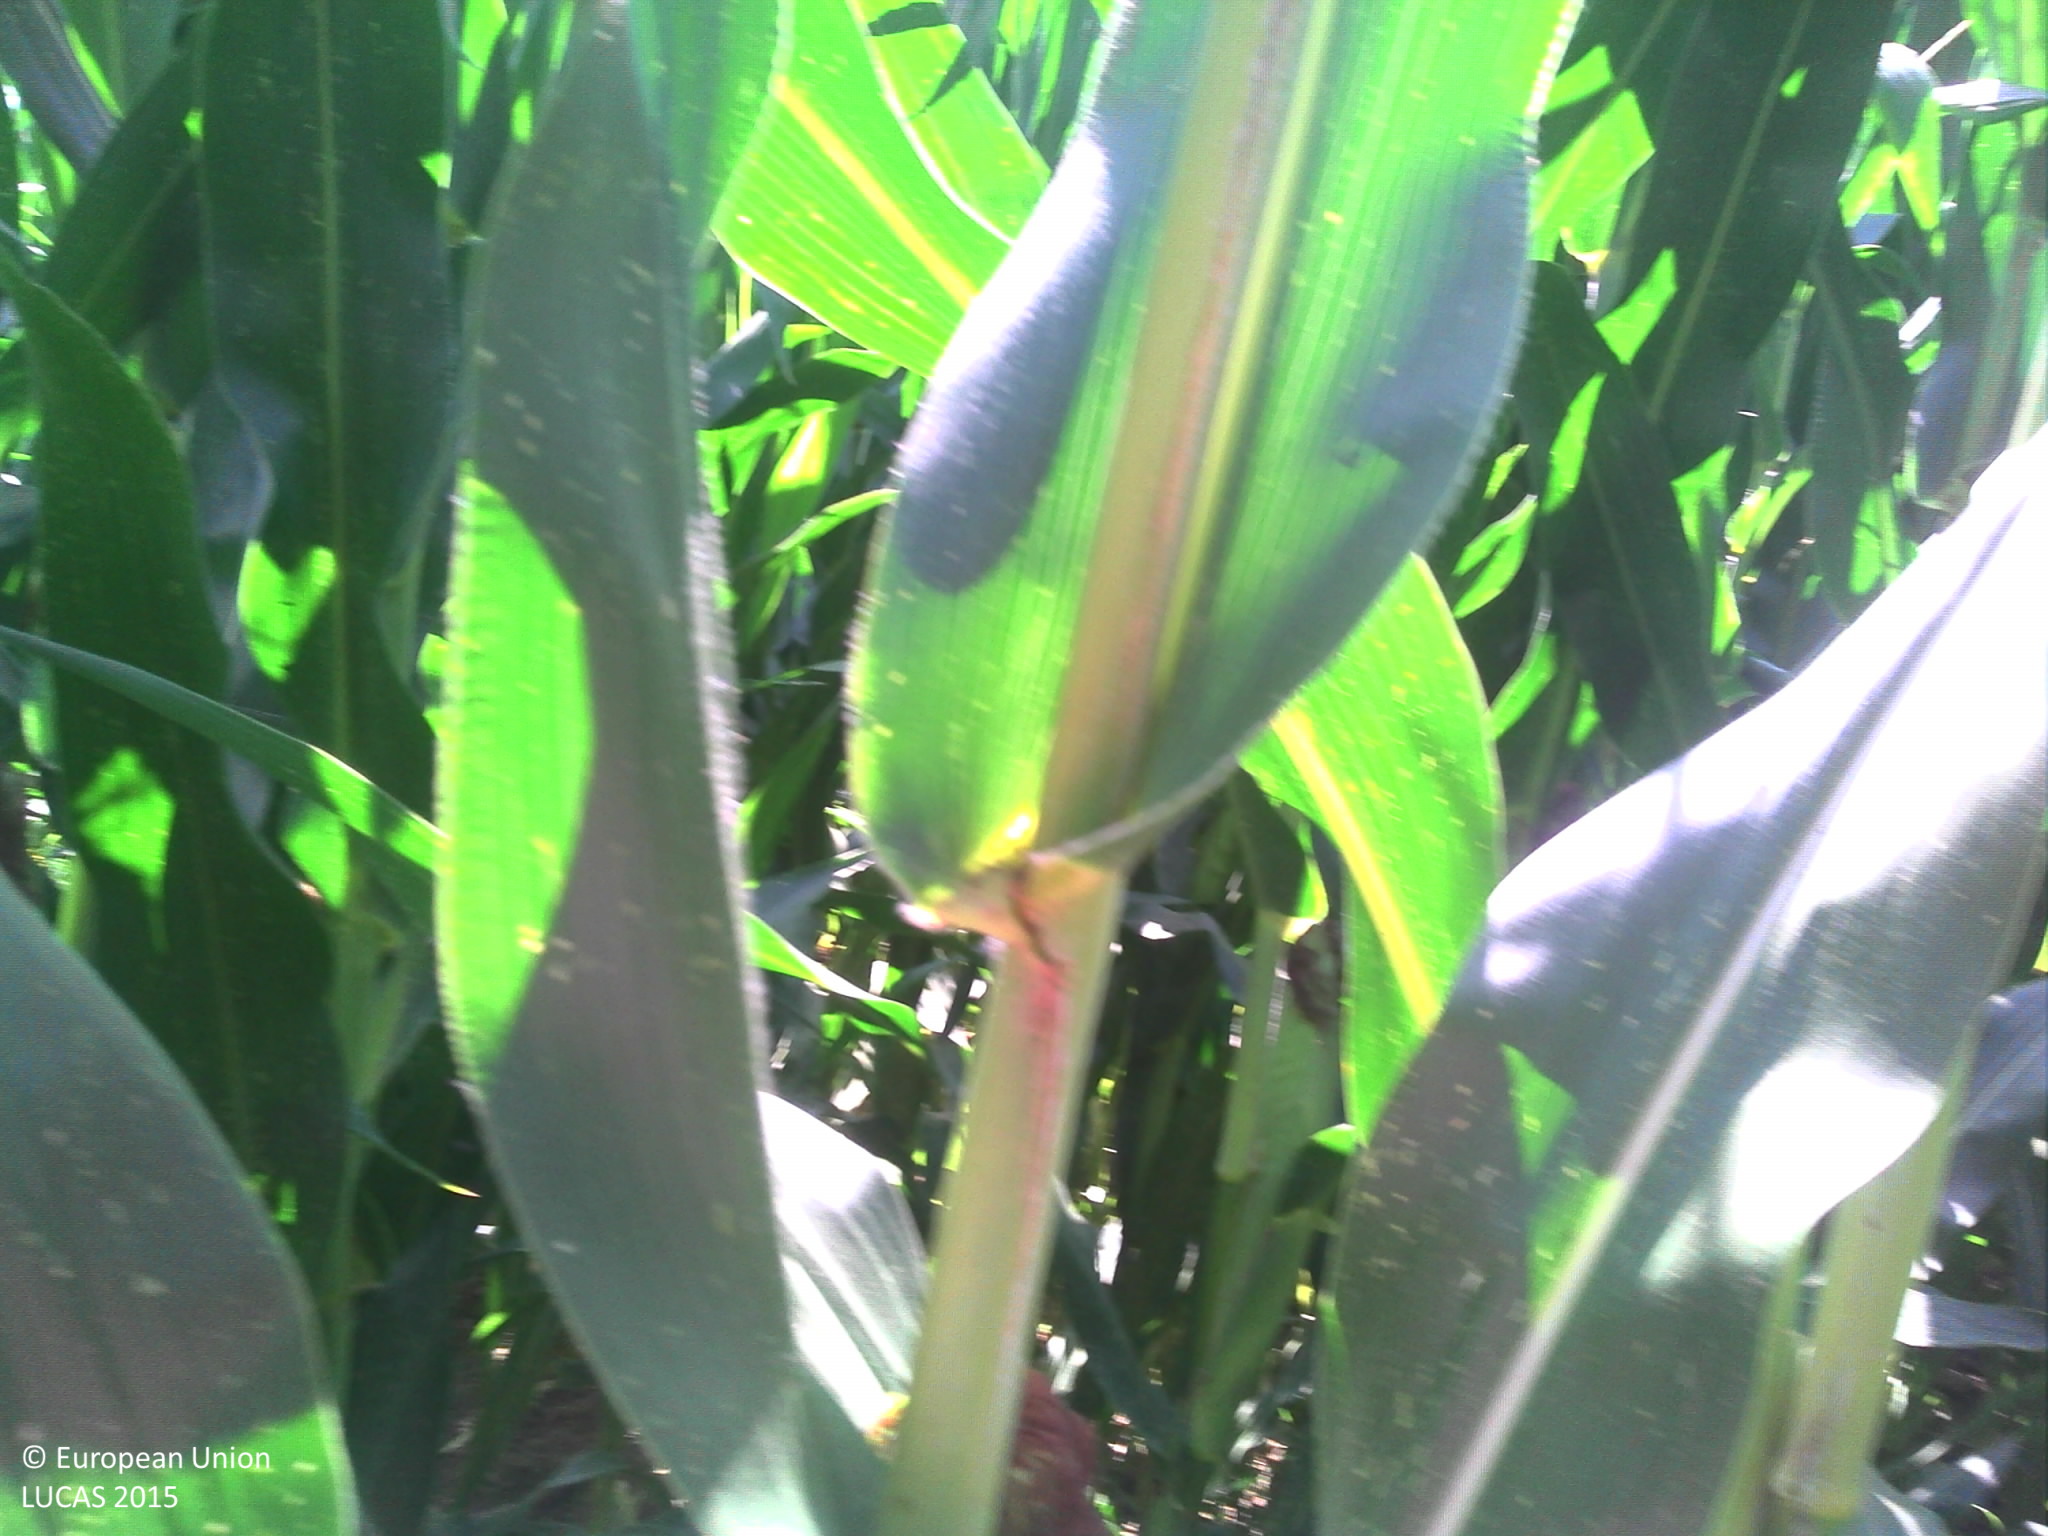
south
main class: Cropland
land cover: Maize
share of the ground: > 75 %
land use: Agriculture (excluding fallow land and kitchen gardens)
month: August
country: FR
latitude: 44.0350
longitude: 1.2521
